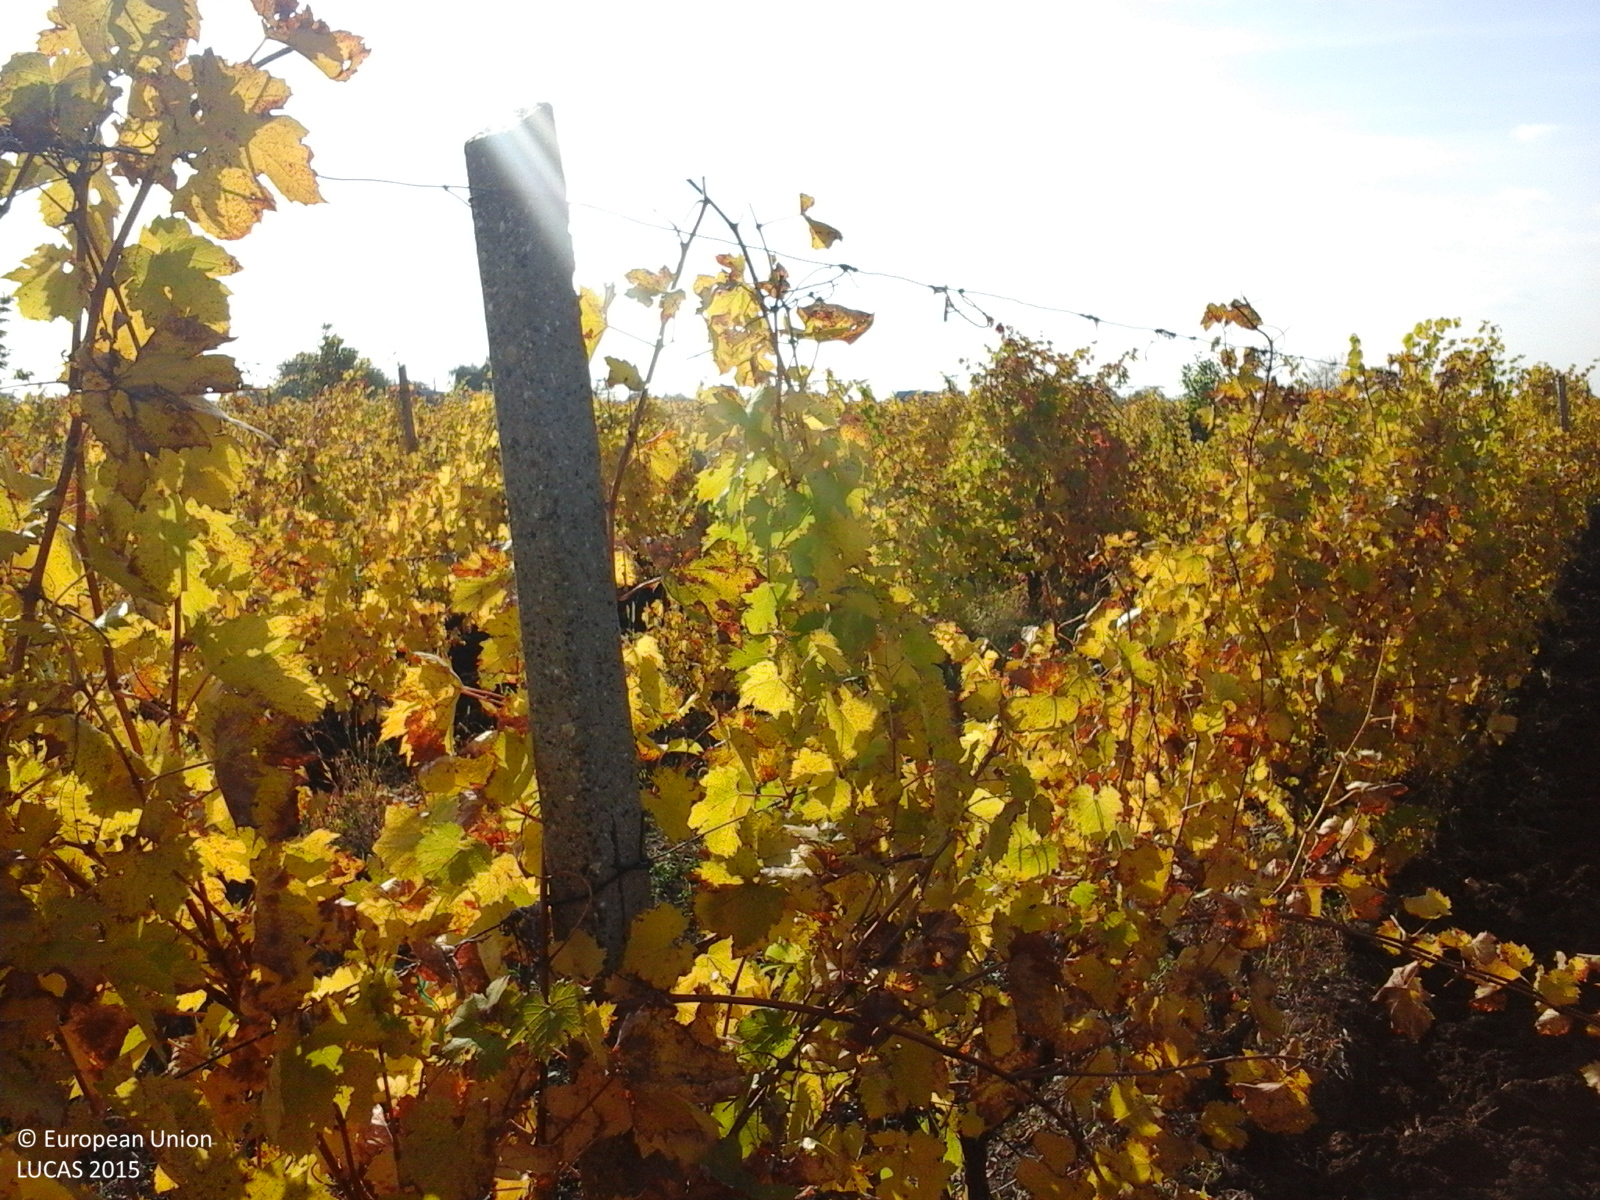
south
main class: Cropland
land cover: Vineyards
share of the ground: > 75 %
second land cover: Other bare soil
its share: > 75 %
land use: Agriculture (excluding fallow land and kitchen gardens)
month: October
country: RO
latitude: 45.5824
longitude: 27.1251
